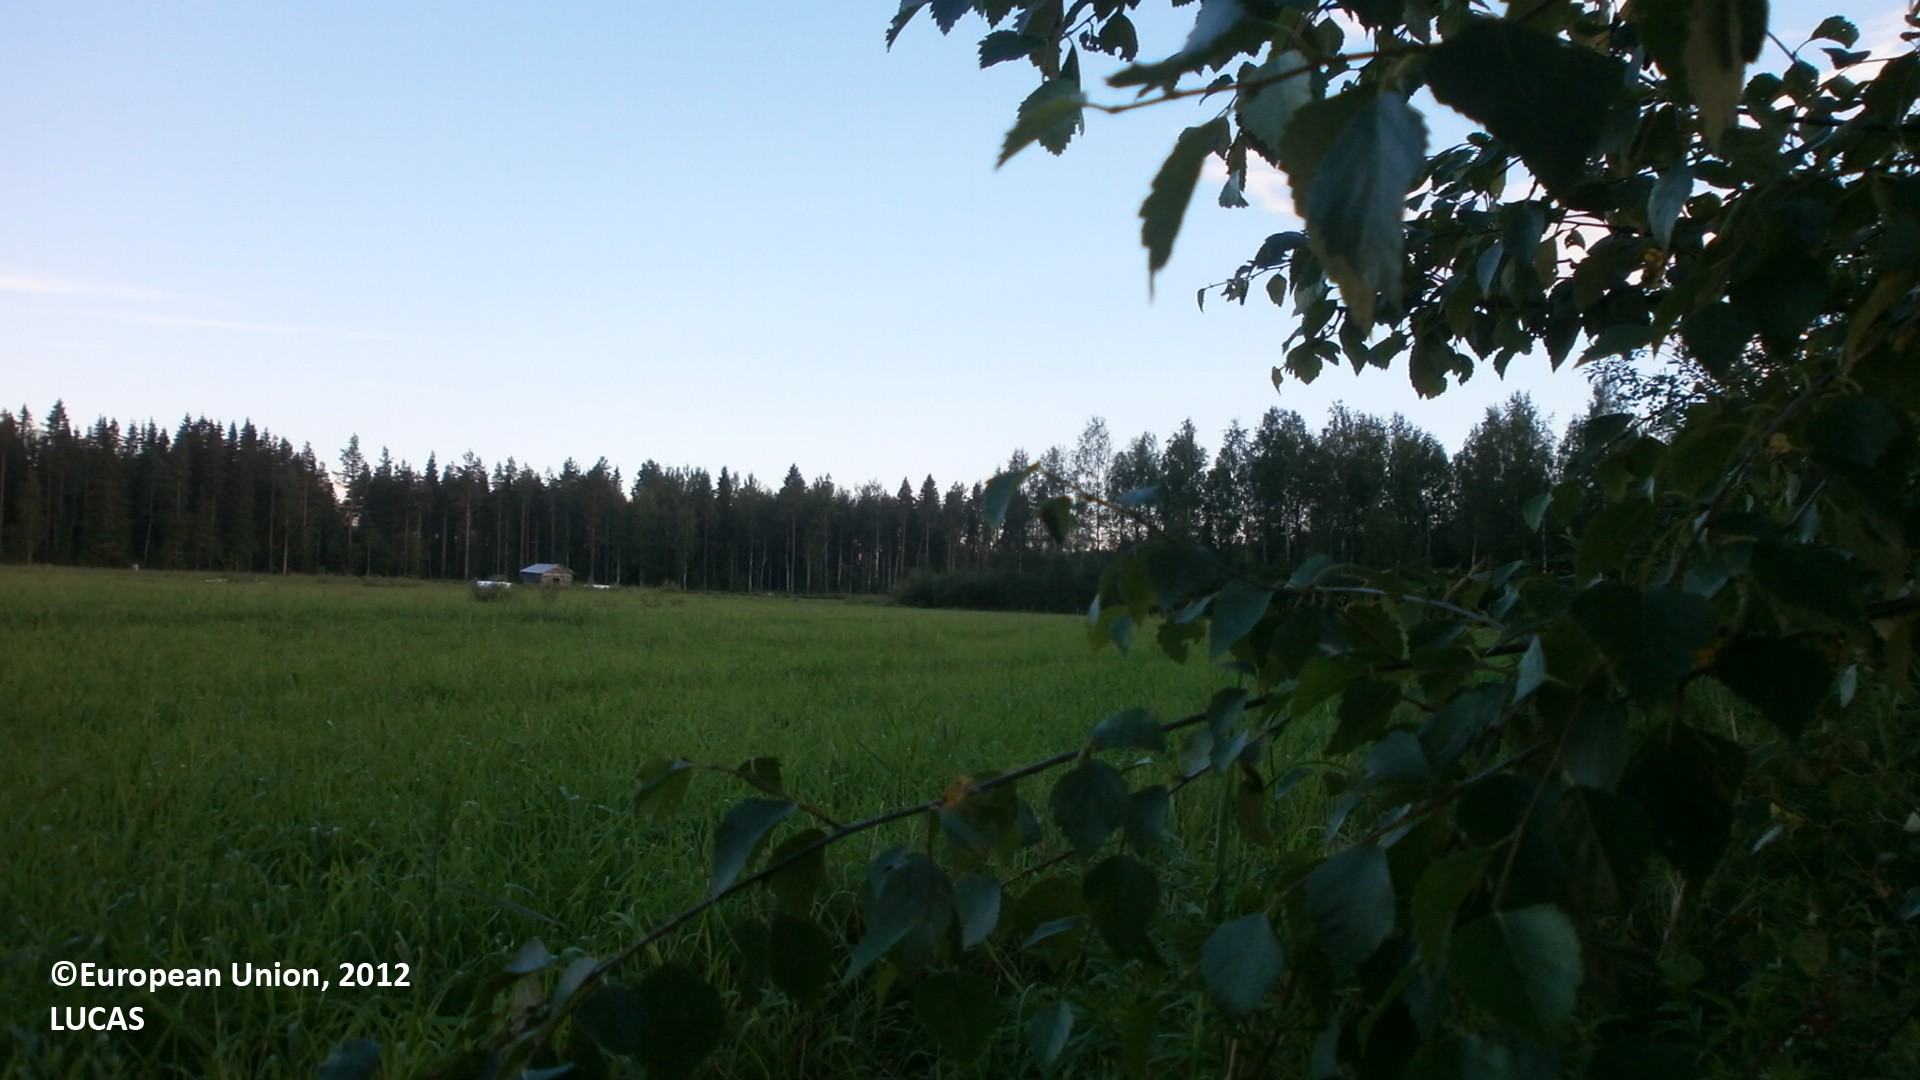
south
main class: Cropland
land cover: Potatoes
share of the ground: 50 - 75 %
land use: Agriculture (excluding fallow land and kitchen gardens)
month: July
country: FI
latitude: 64.1256
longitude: 24.1769
